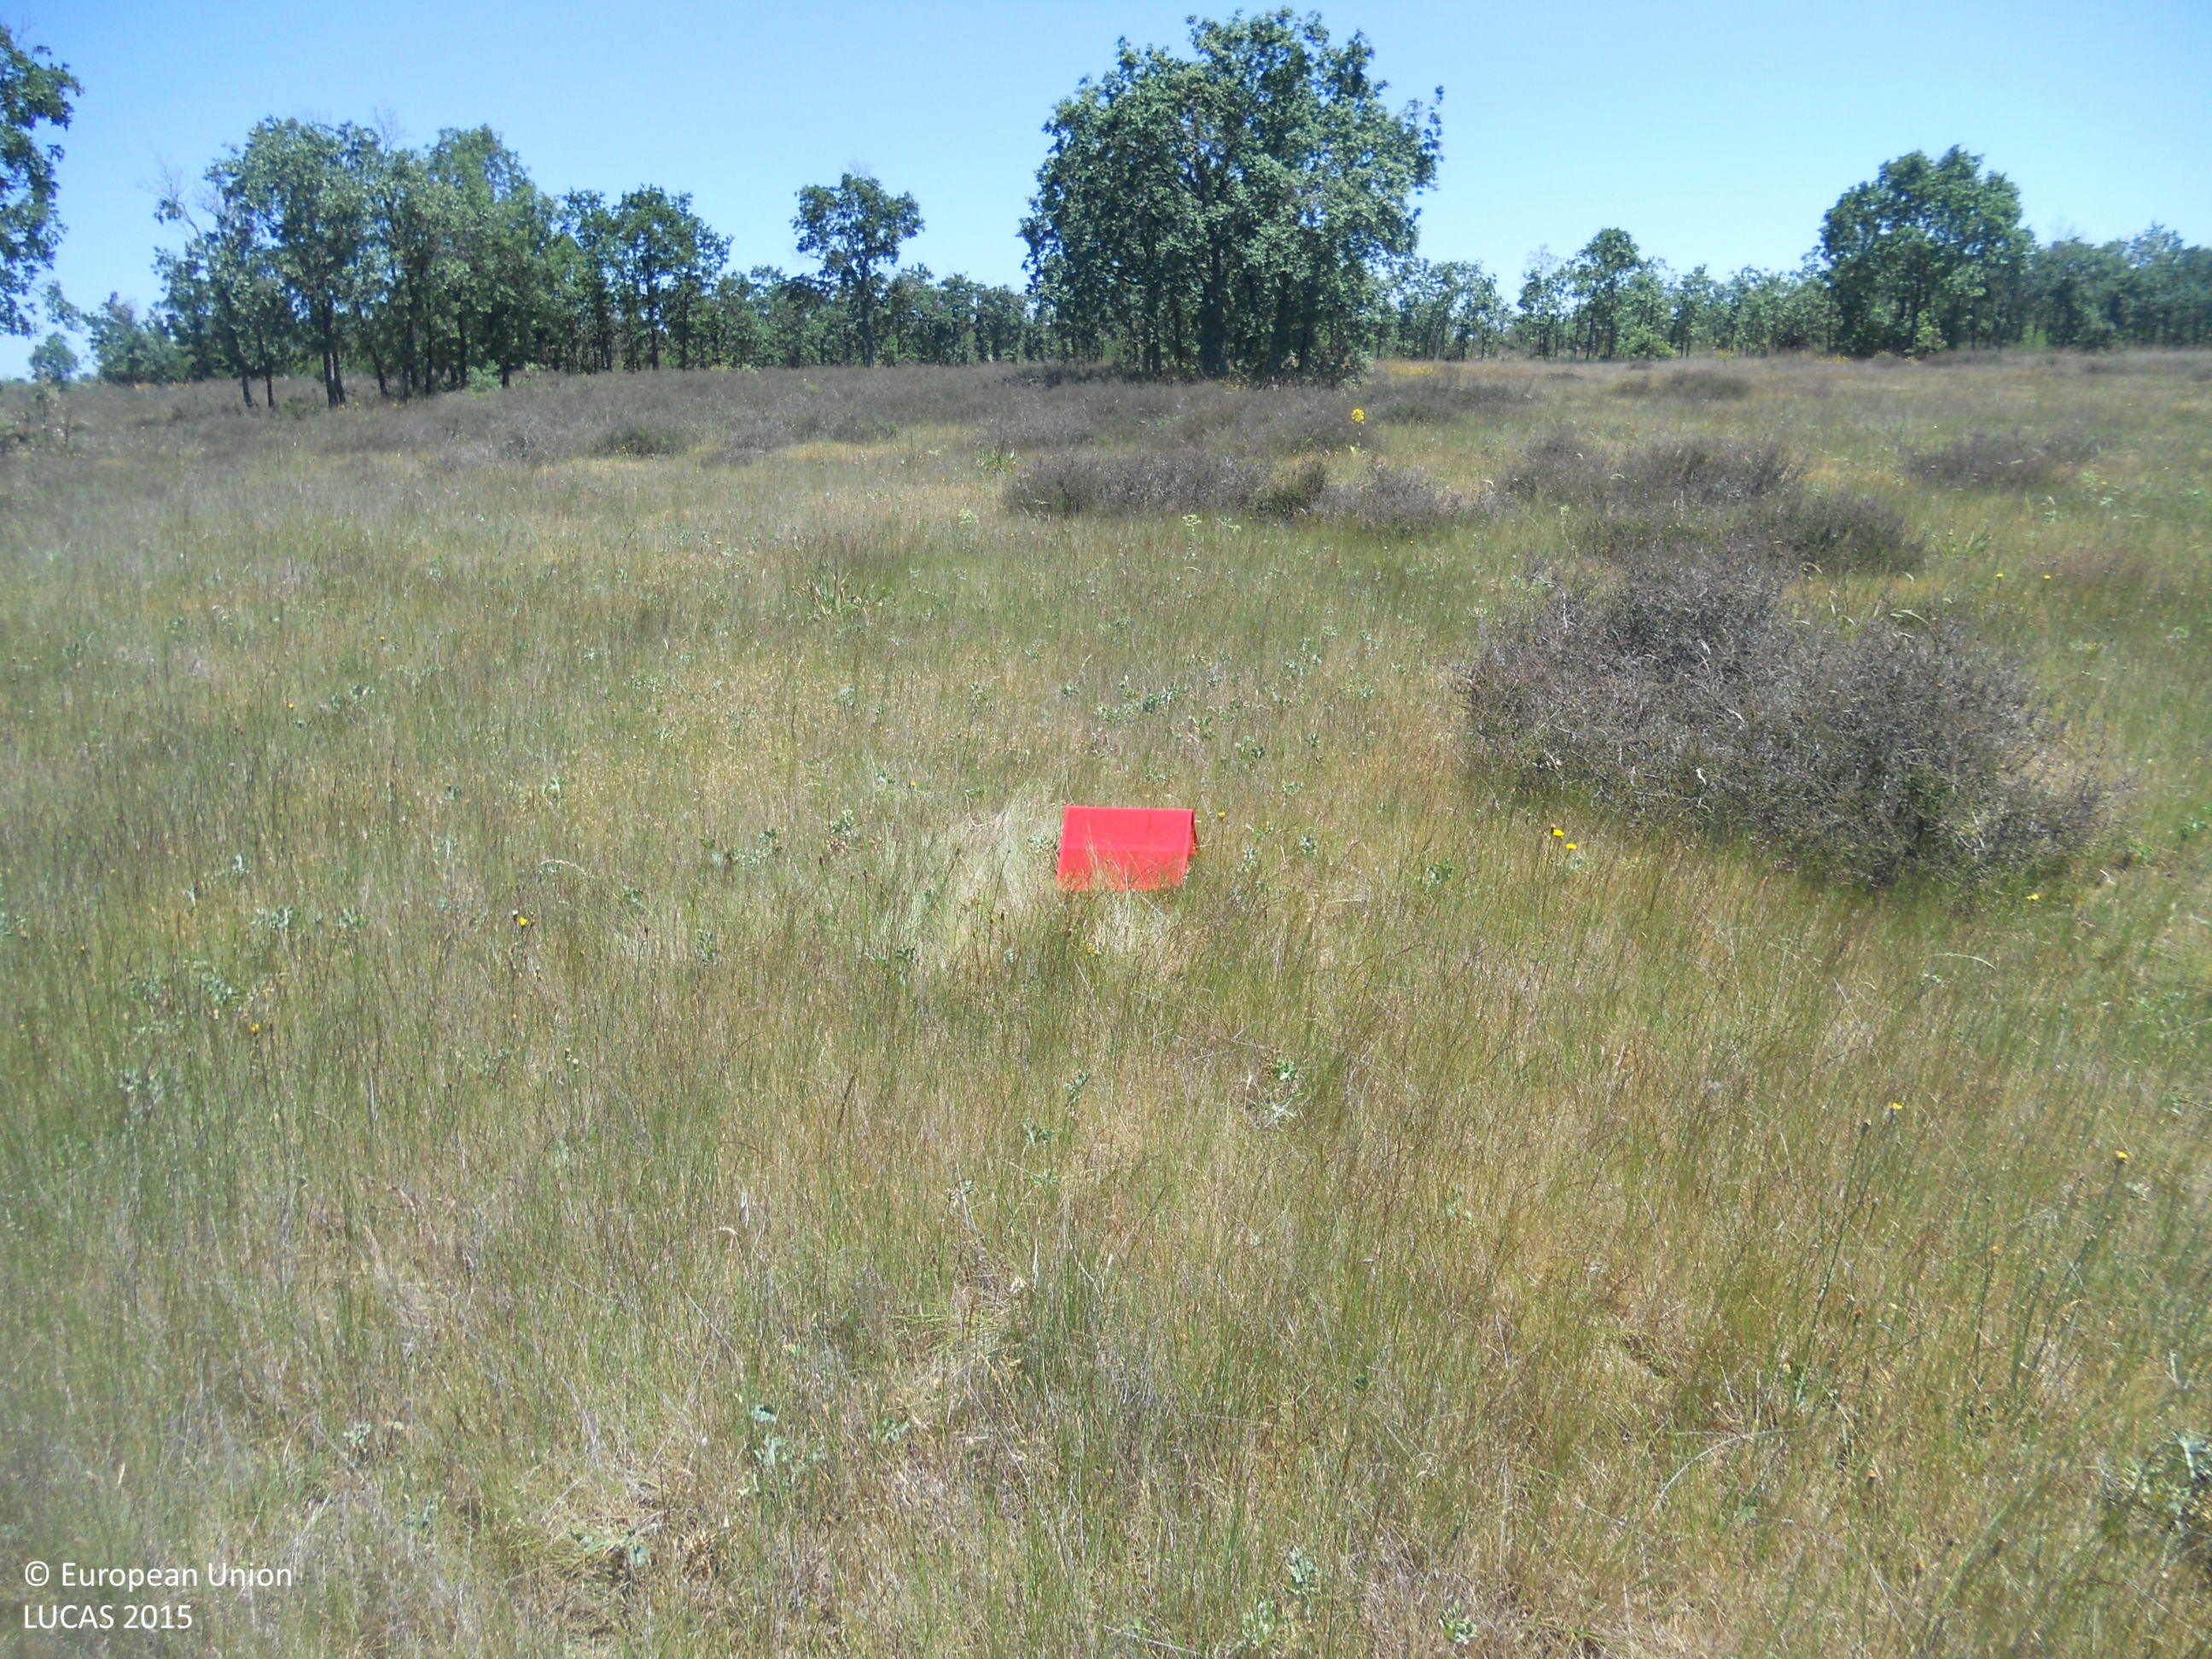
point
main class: Grassland
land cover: Grassland without tree/shrub cover
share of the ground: > 75 %
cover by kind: herbaceous plants 95 %, shrubs 5 %
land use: Forestry
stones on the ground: > 50 %
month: June
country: ES
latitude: 42.4888
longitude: -4.8392
